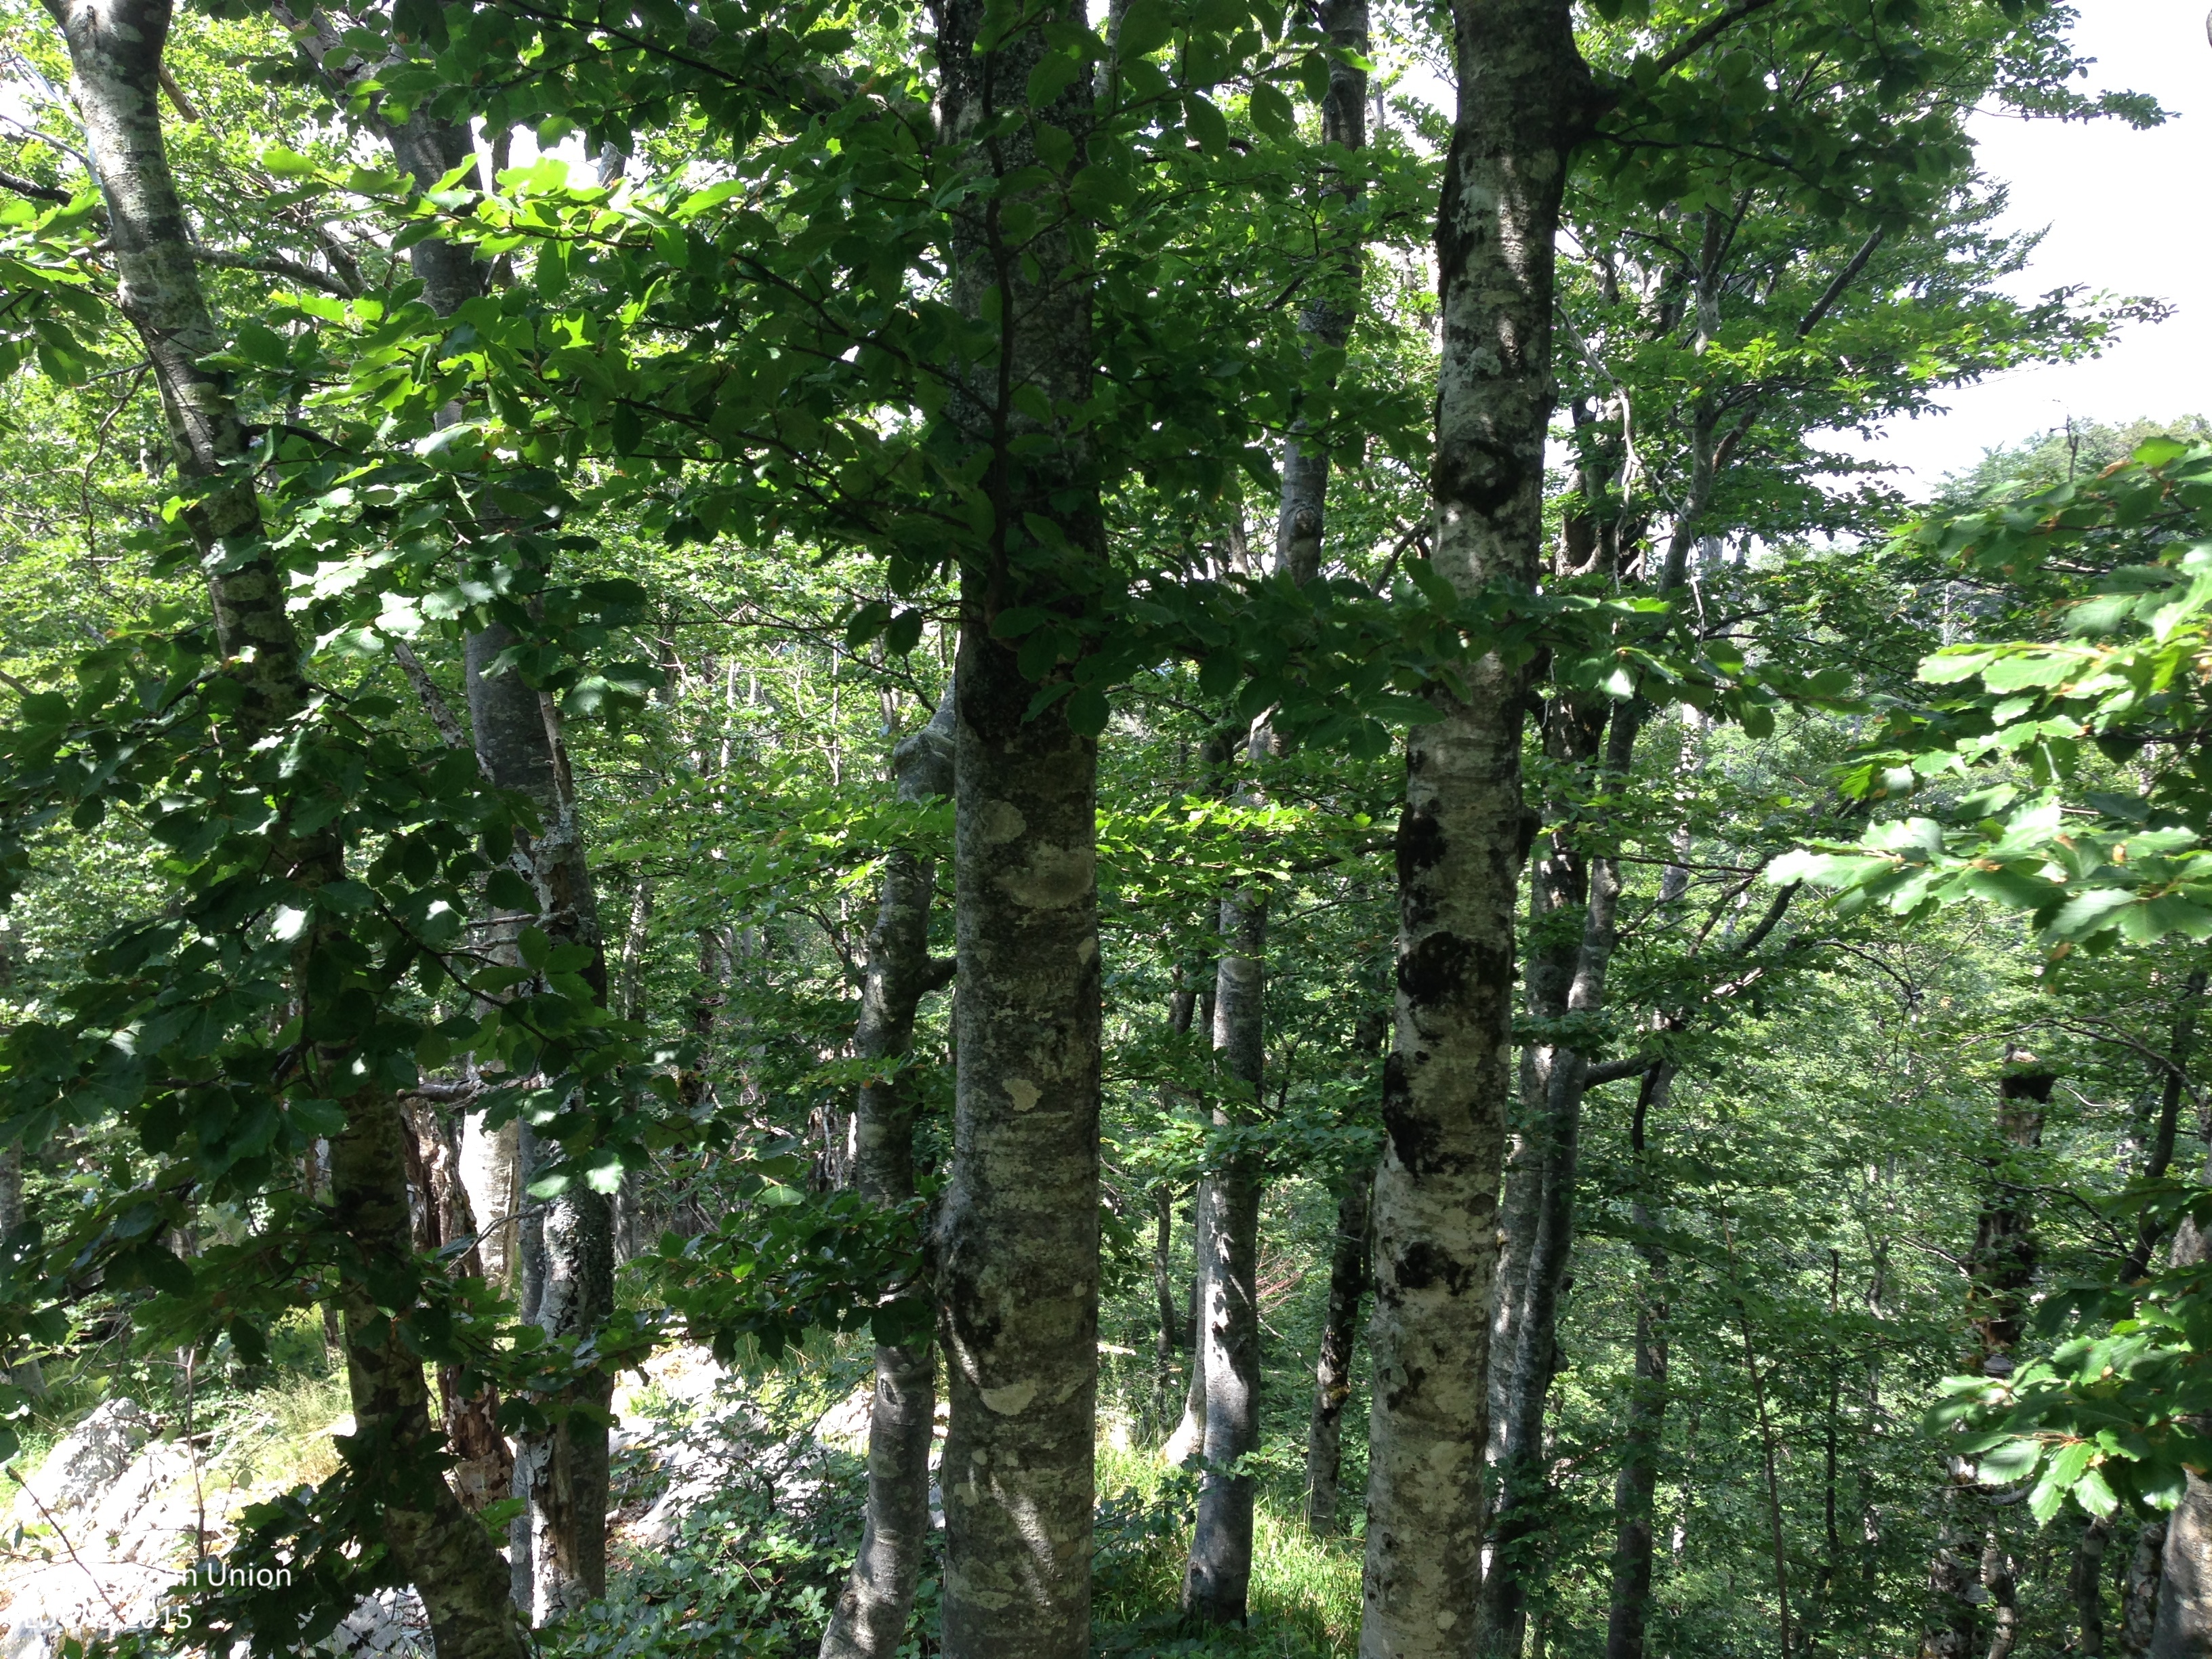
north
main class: Woodland
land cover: Other mixed woodland
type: thermophilous deciduous forest
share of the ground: > 75 %
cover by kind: broadleaved forest trees 40 %, coniferous forest trees 20 %, herbaceous plants 20 %, consolidated bare surface 10 %, shrubs 5 %, unconsolidated bare surface 5 %
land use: Forestry
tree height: > 5 m
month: July
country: HR
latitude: 44.6240
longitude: 15.0727
